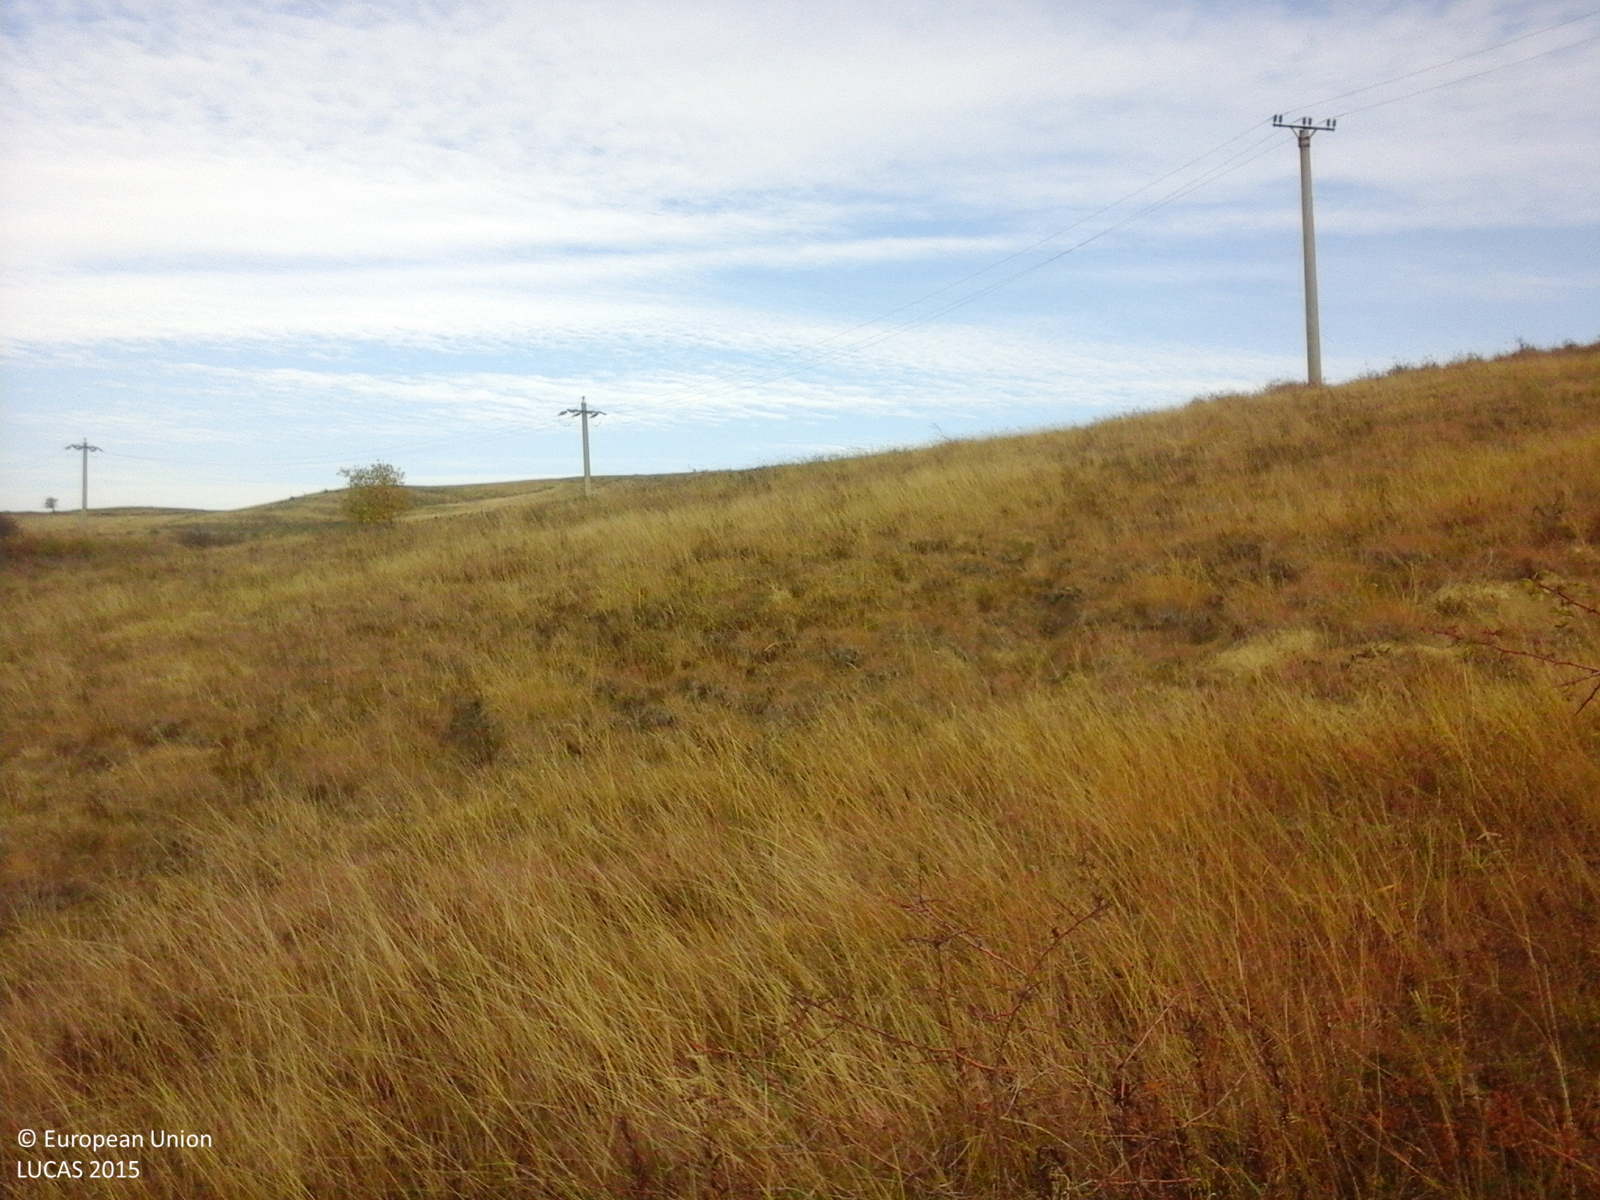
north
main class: Grassland
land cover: Grassland with sparse tree/shrub cover
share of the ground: > 75 %
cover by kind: herbaceous plants 85 %, shrubs 10 %, broadleaved forest trees 5 %
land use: Forestry
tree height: < 5 m
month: October
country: RO
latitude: 45.0876
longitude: 26.3161
